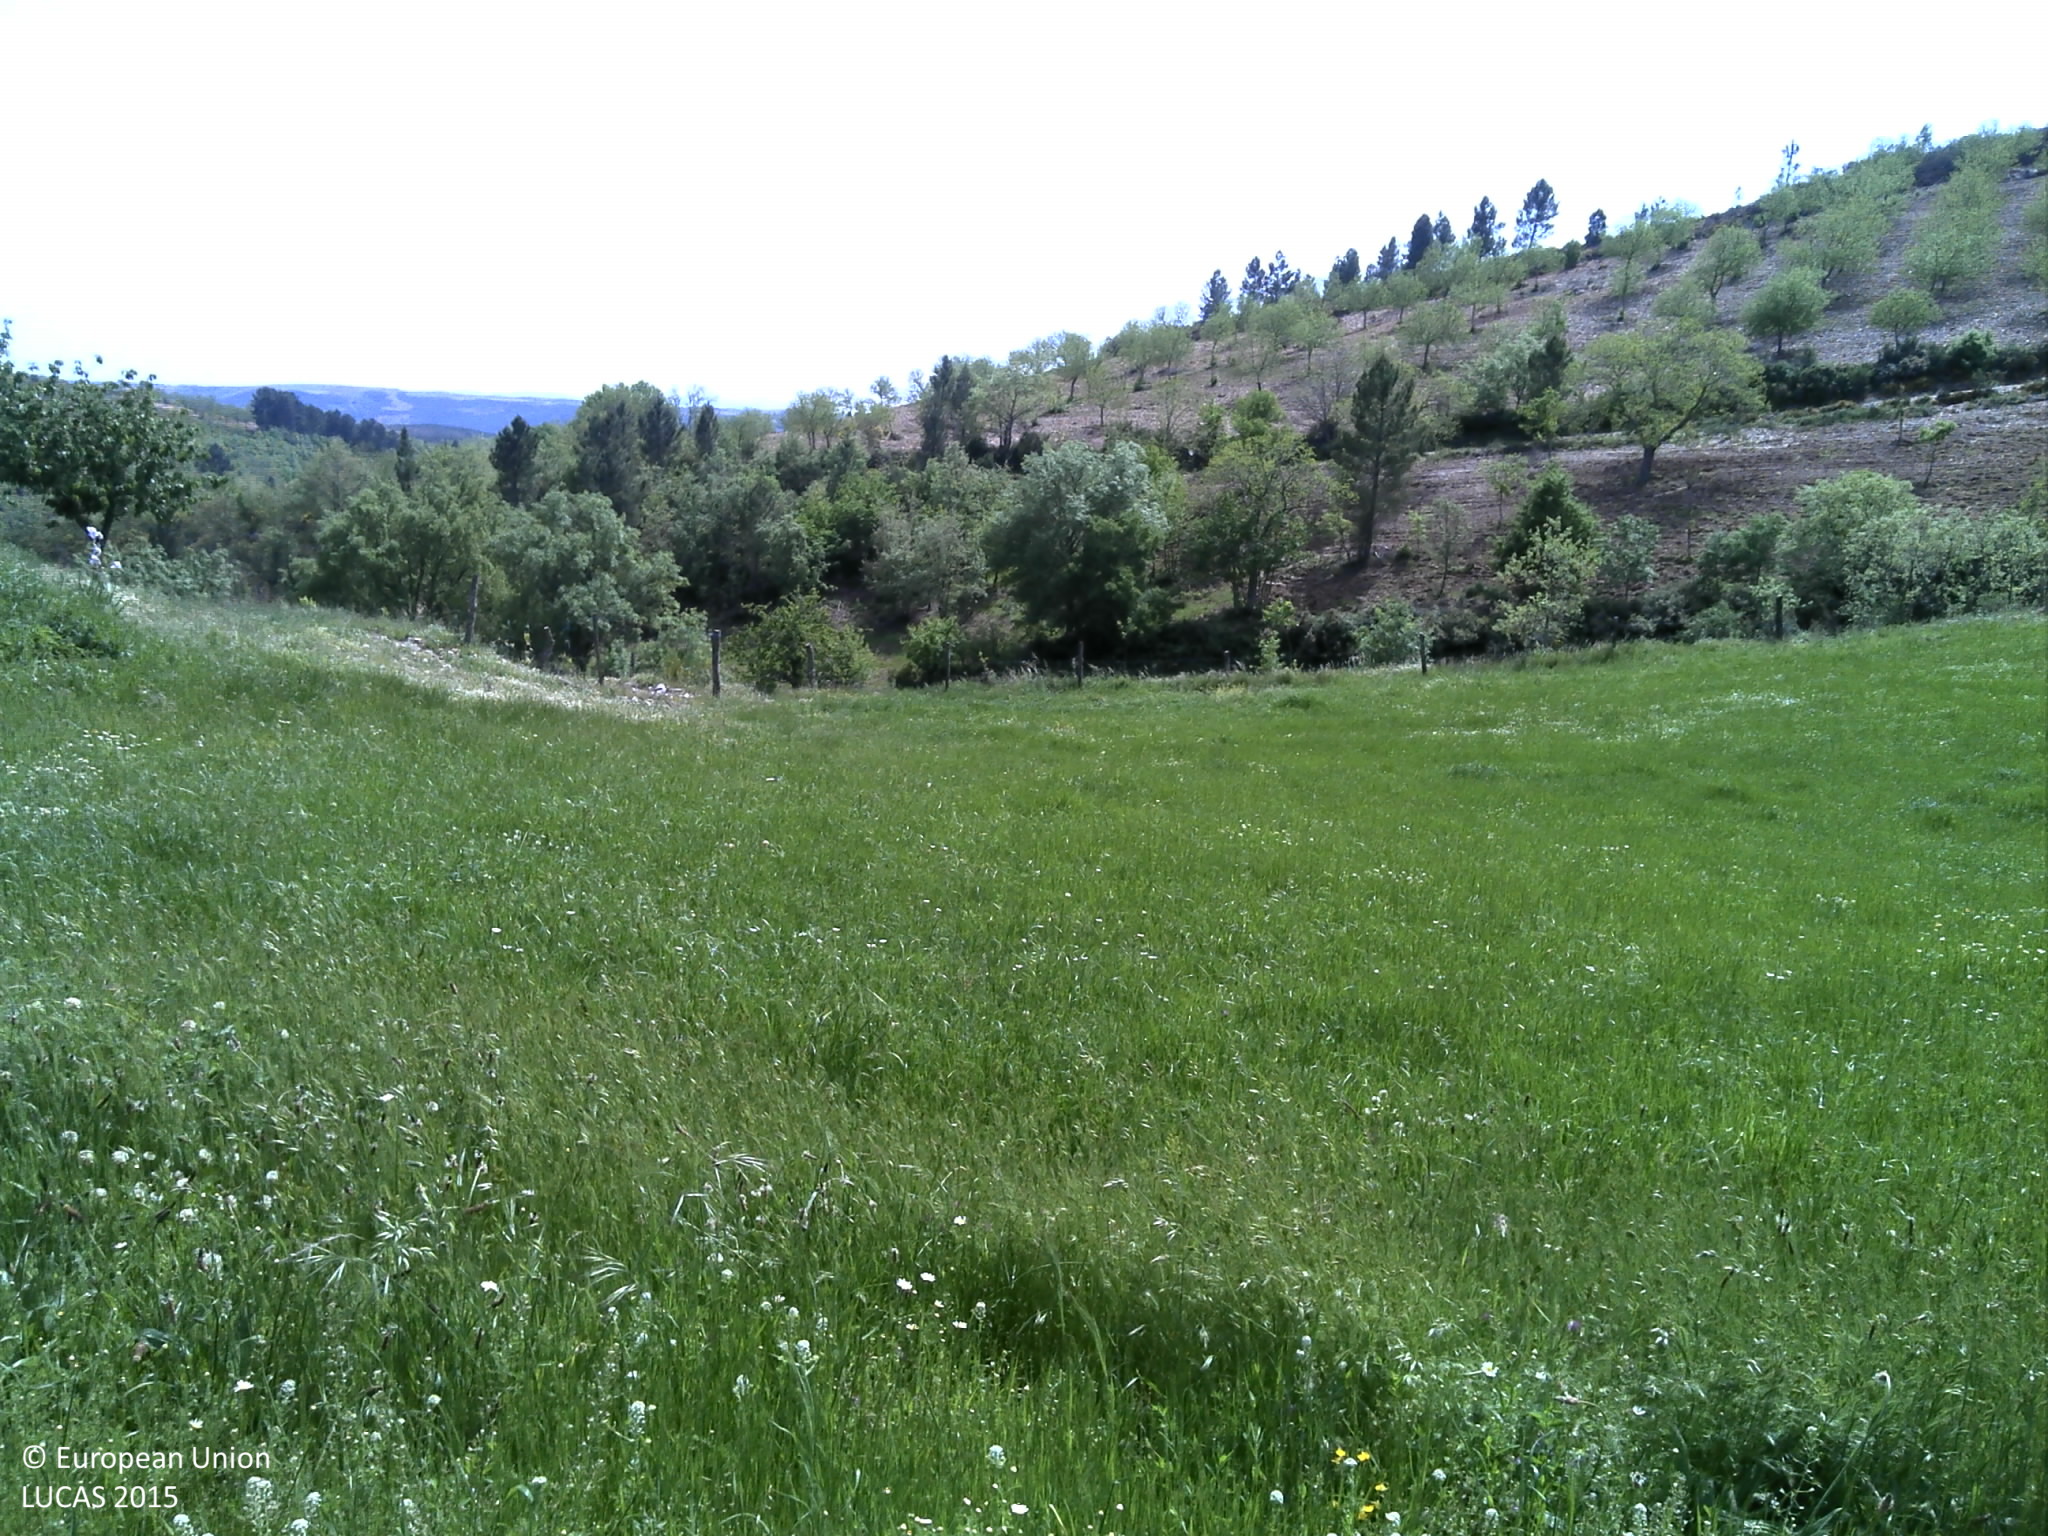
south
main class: Grassland
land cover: Spontaneously vegetated surfaces
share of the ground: > 75 %
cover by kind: herbaceous plants 95 %, unconsolidated bare surface 5 %
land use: Agriculture (excluding fallow land and kitchen gardens)
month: May
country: PT
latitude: 41.7623
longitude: -6.9691
